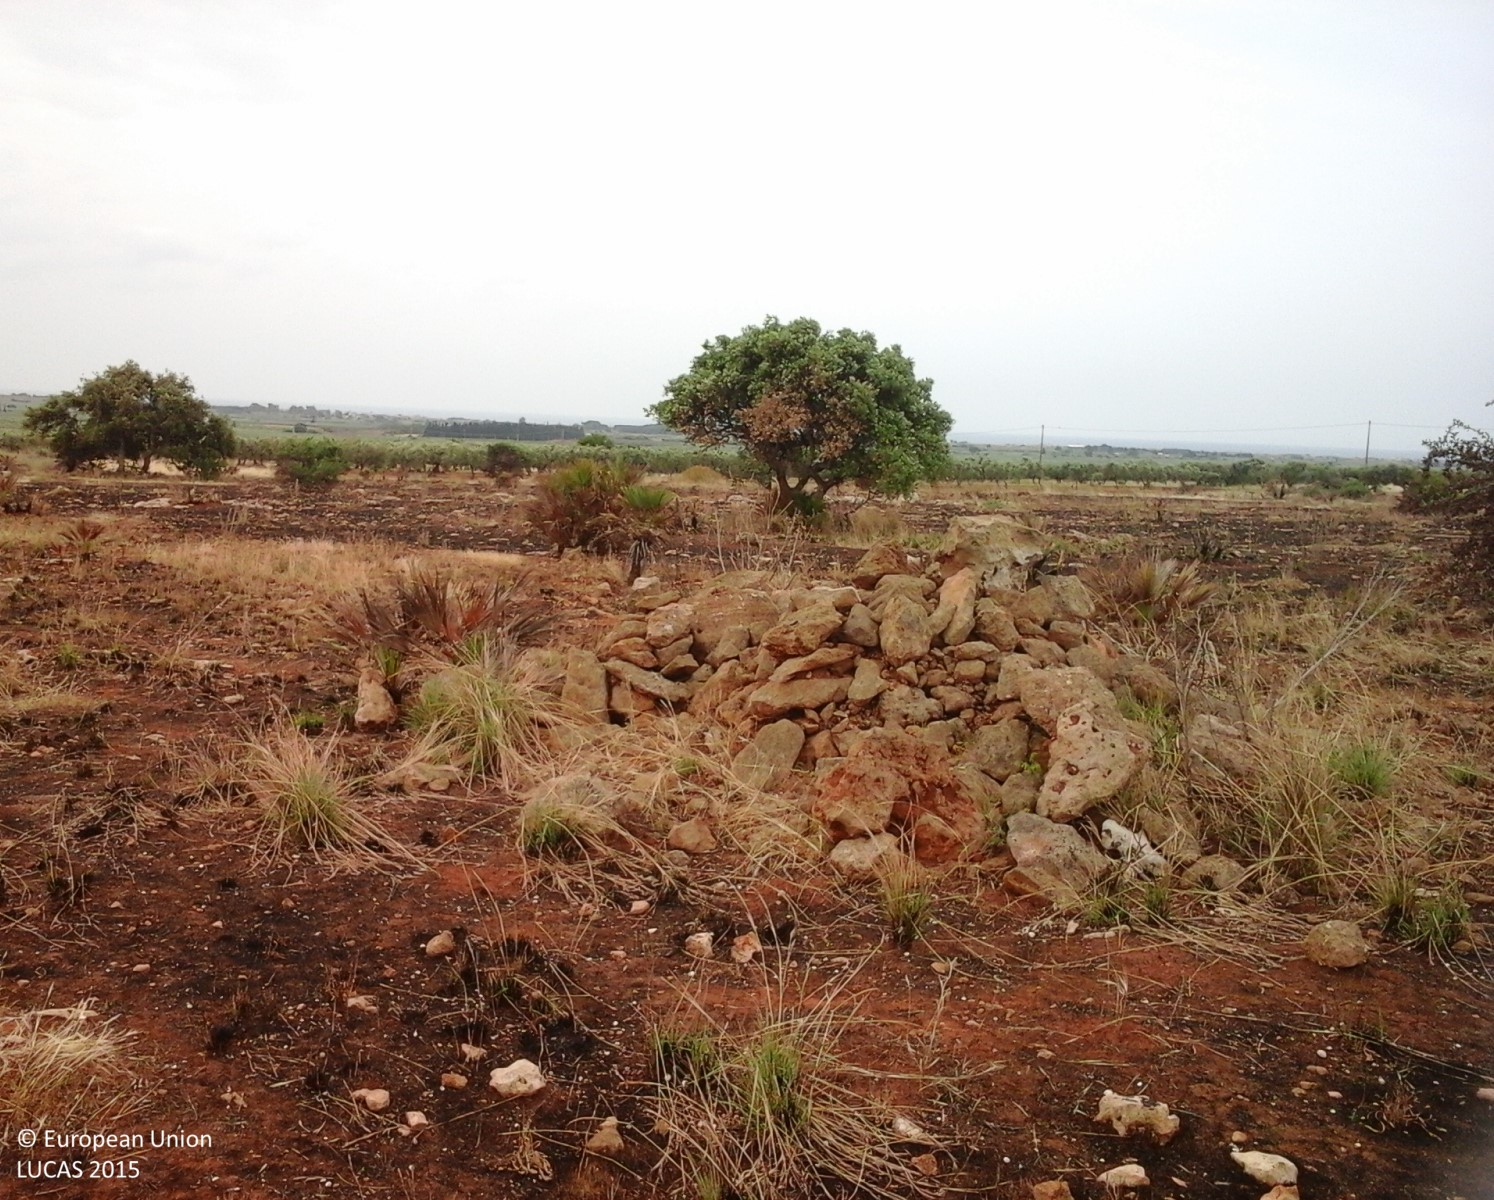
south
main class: Grassland
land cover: Grassland with sparse tree/shrub cover
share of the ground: > 75 %
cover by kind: consolidated bare surface 65 %, herbaceous plants 20 %, shrubs 10 %, coniferous forest trees 5 %
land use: Semi-natural and natural areas not in use
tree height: < 5 m
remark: Burnt area
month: May
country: IT
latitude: 37.6168
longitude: 12.7546
